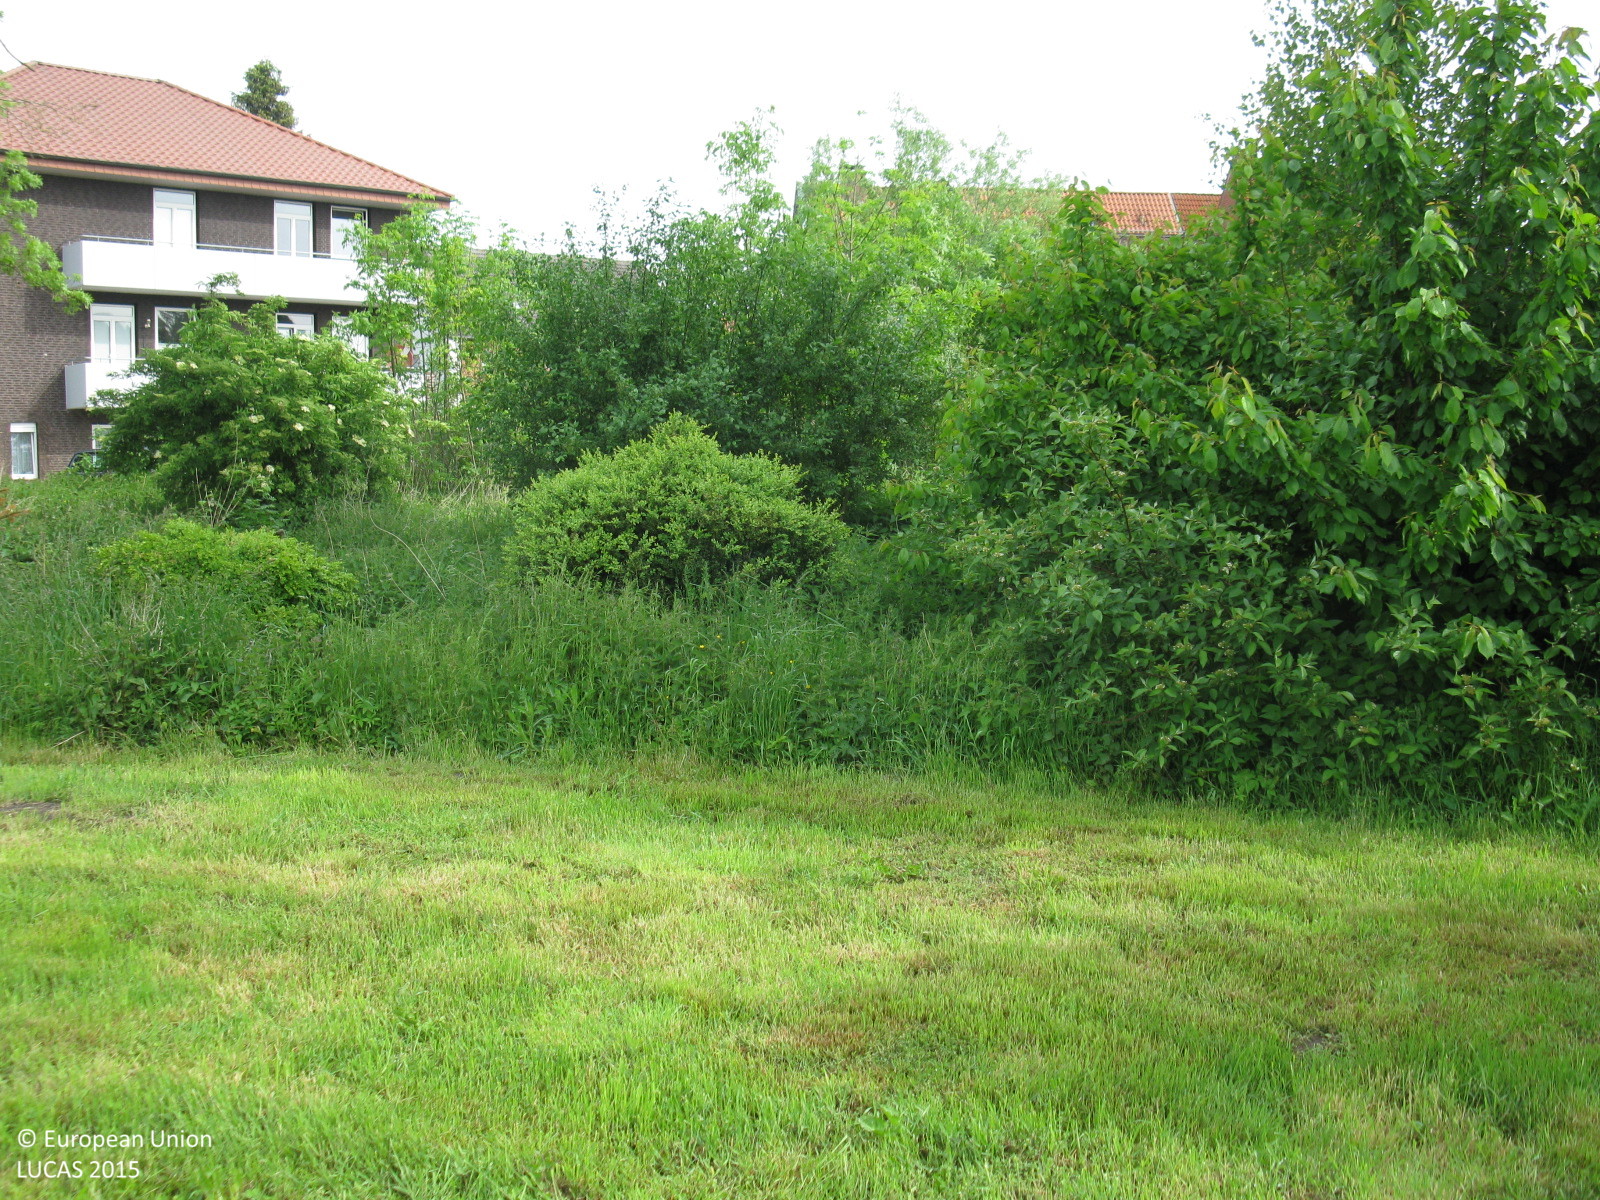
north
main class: Grassland
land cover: Grassland without tree/shrub cover
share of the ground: > 75 %
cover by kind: herbaceous plants 100 %
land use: Residential
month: June
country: DE
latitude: 53.0488
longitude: 7.3303
